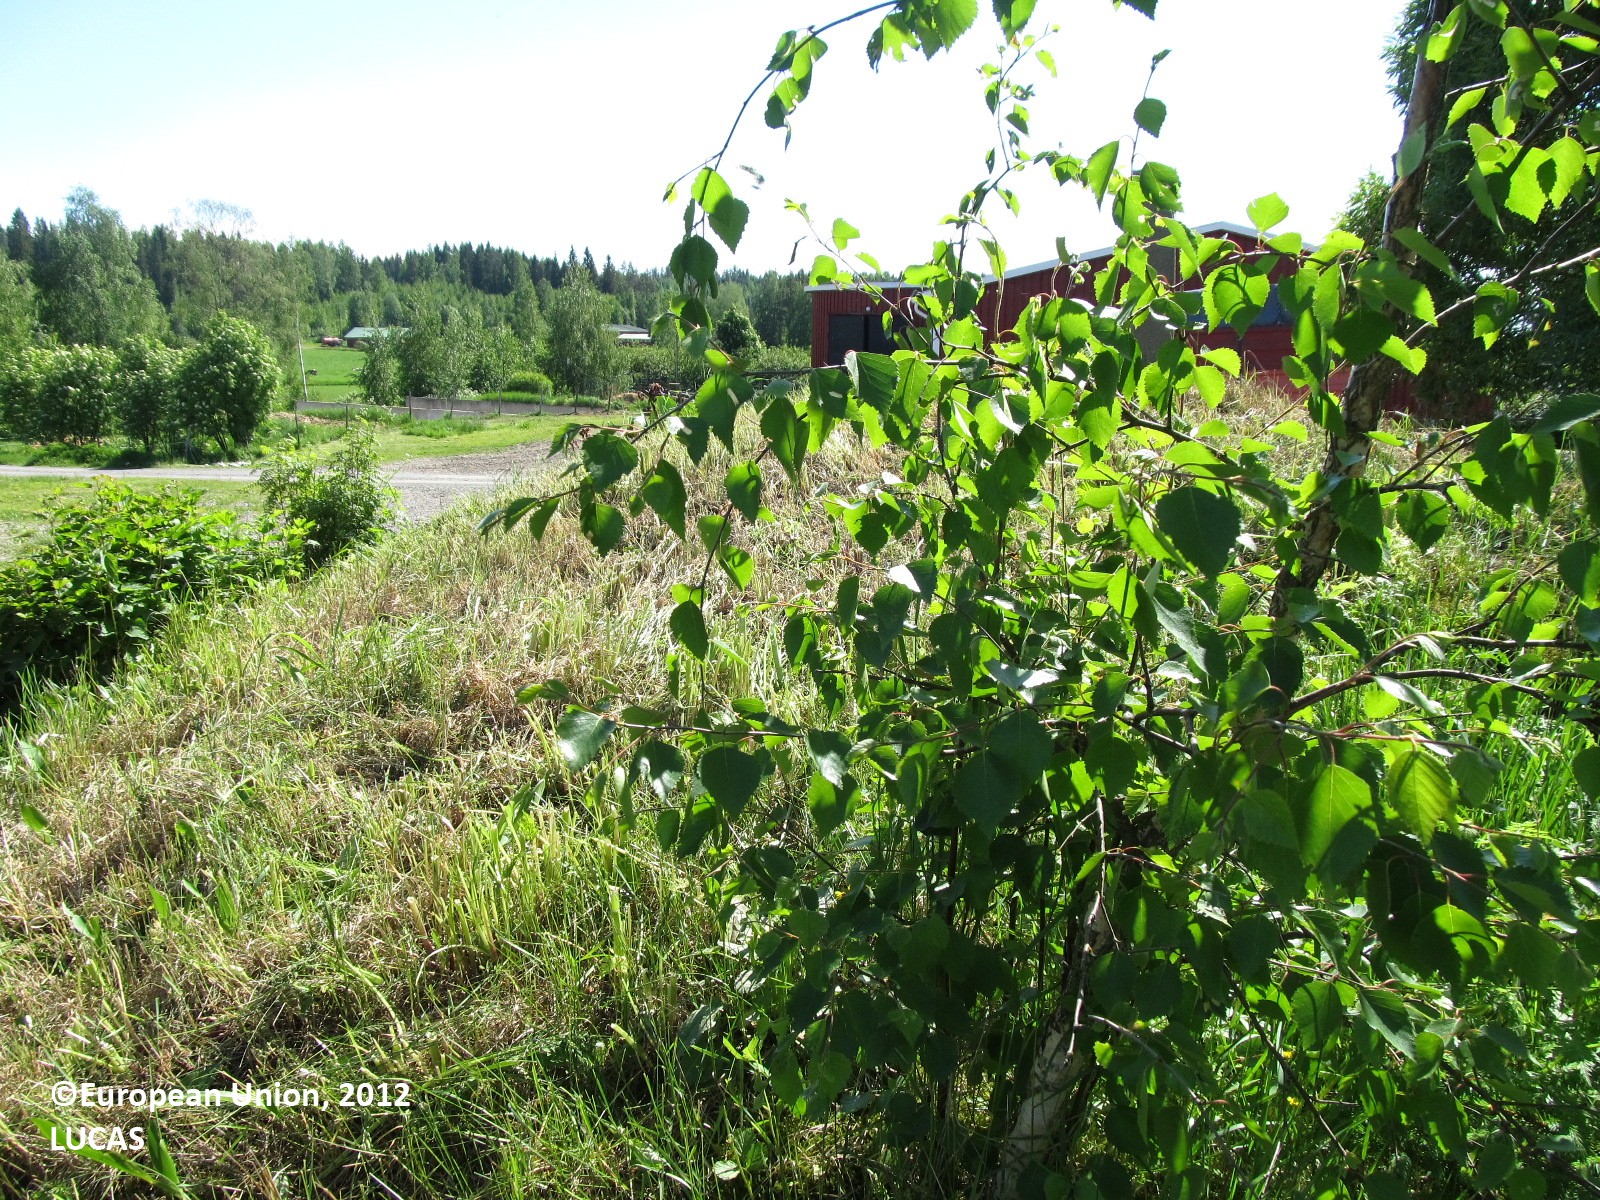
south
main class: Grassland
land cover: Grassland without tree/shrub cover
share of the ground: > 75 %
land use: Agriculture (excluding fallow land and kitchen gardens)
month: June
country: FI
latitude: 63.0323
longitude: 27.5772
